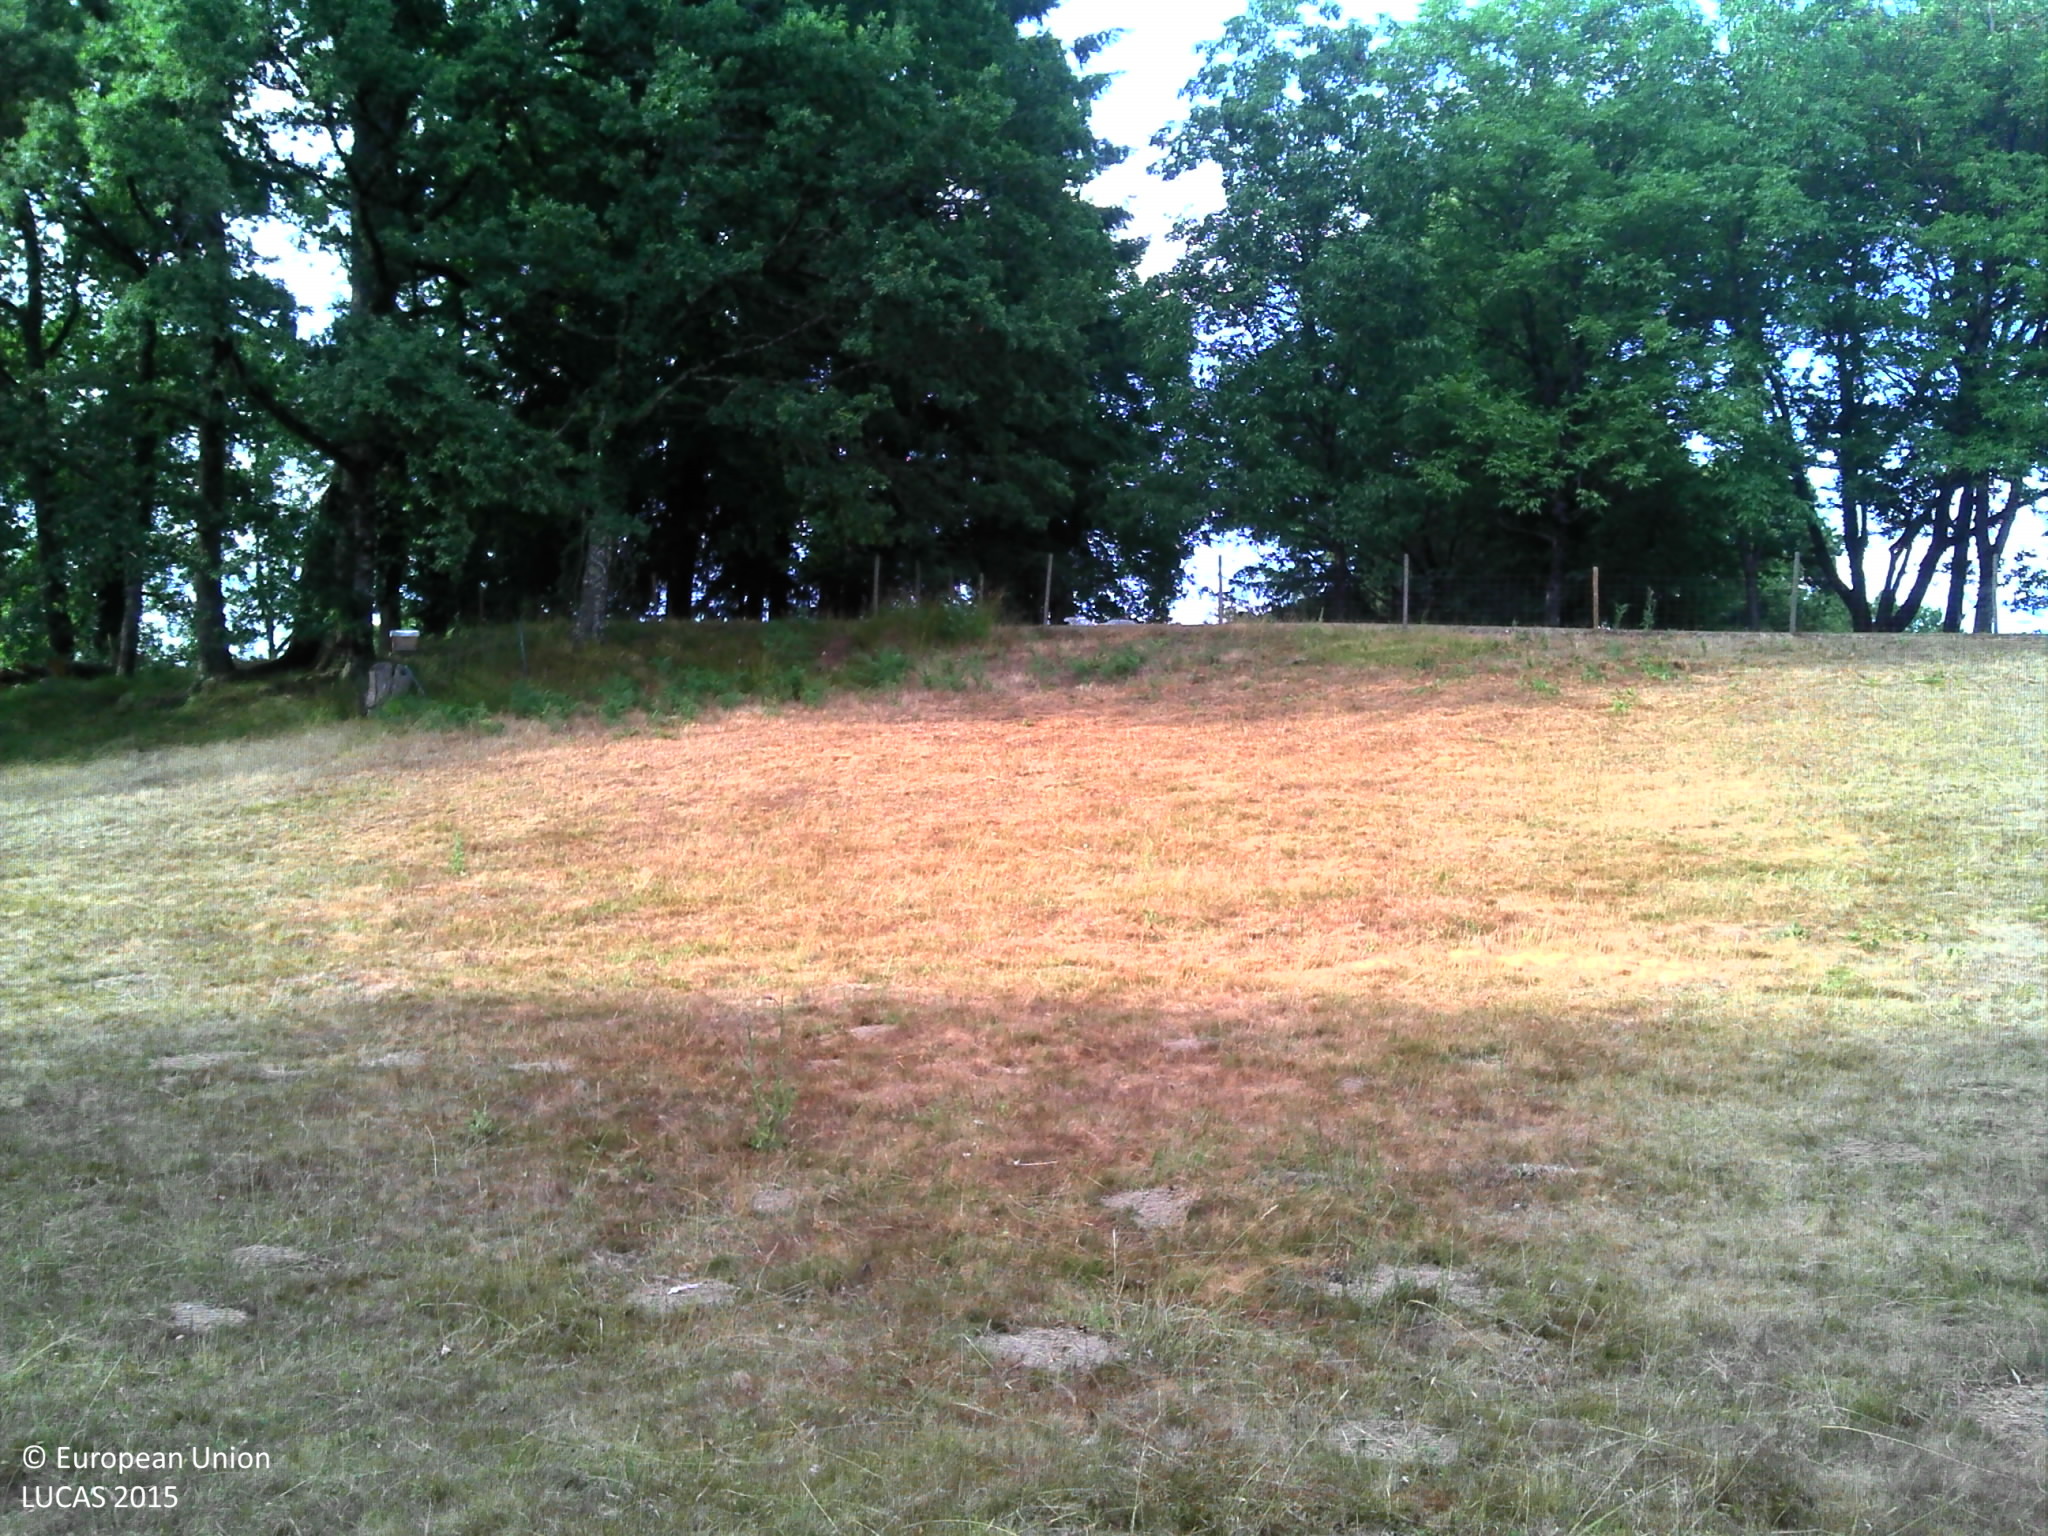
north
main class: Grassland
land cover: Grassland without tree/shrub cover
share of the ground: > 75 %
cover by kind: herbaceous plants 80 %, unconsolidated bare surface 15 %, shrubs 5 %
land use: Agriculture (excluding fallow land and kitchen gardens)
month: July
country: FR
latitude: 45.3821
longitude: 1.3216
